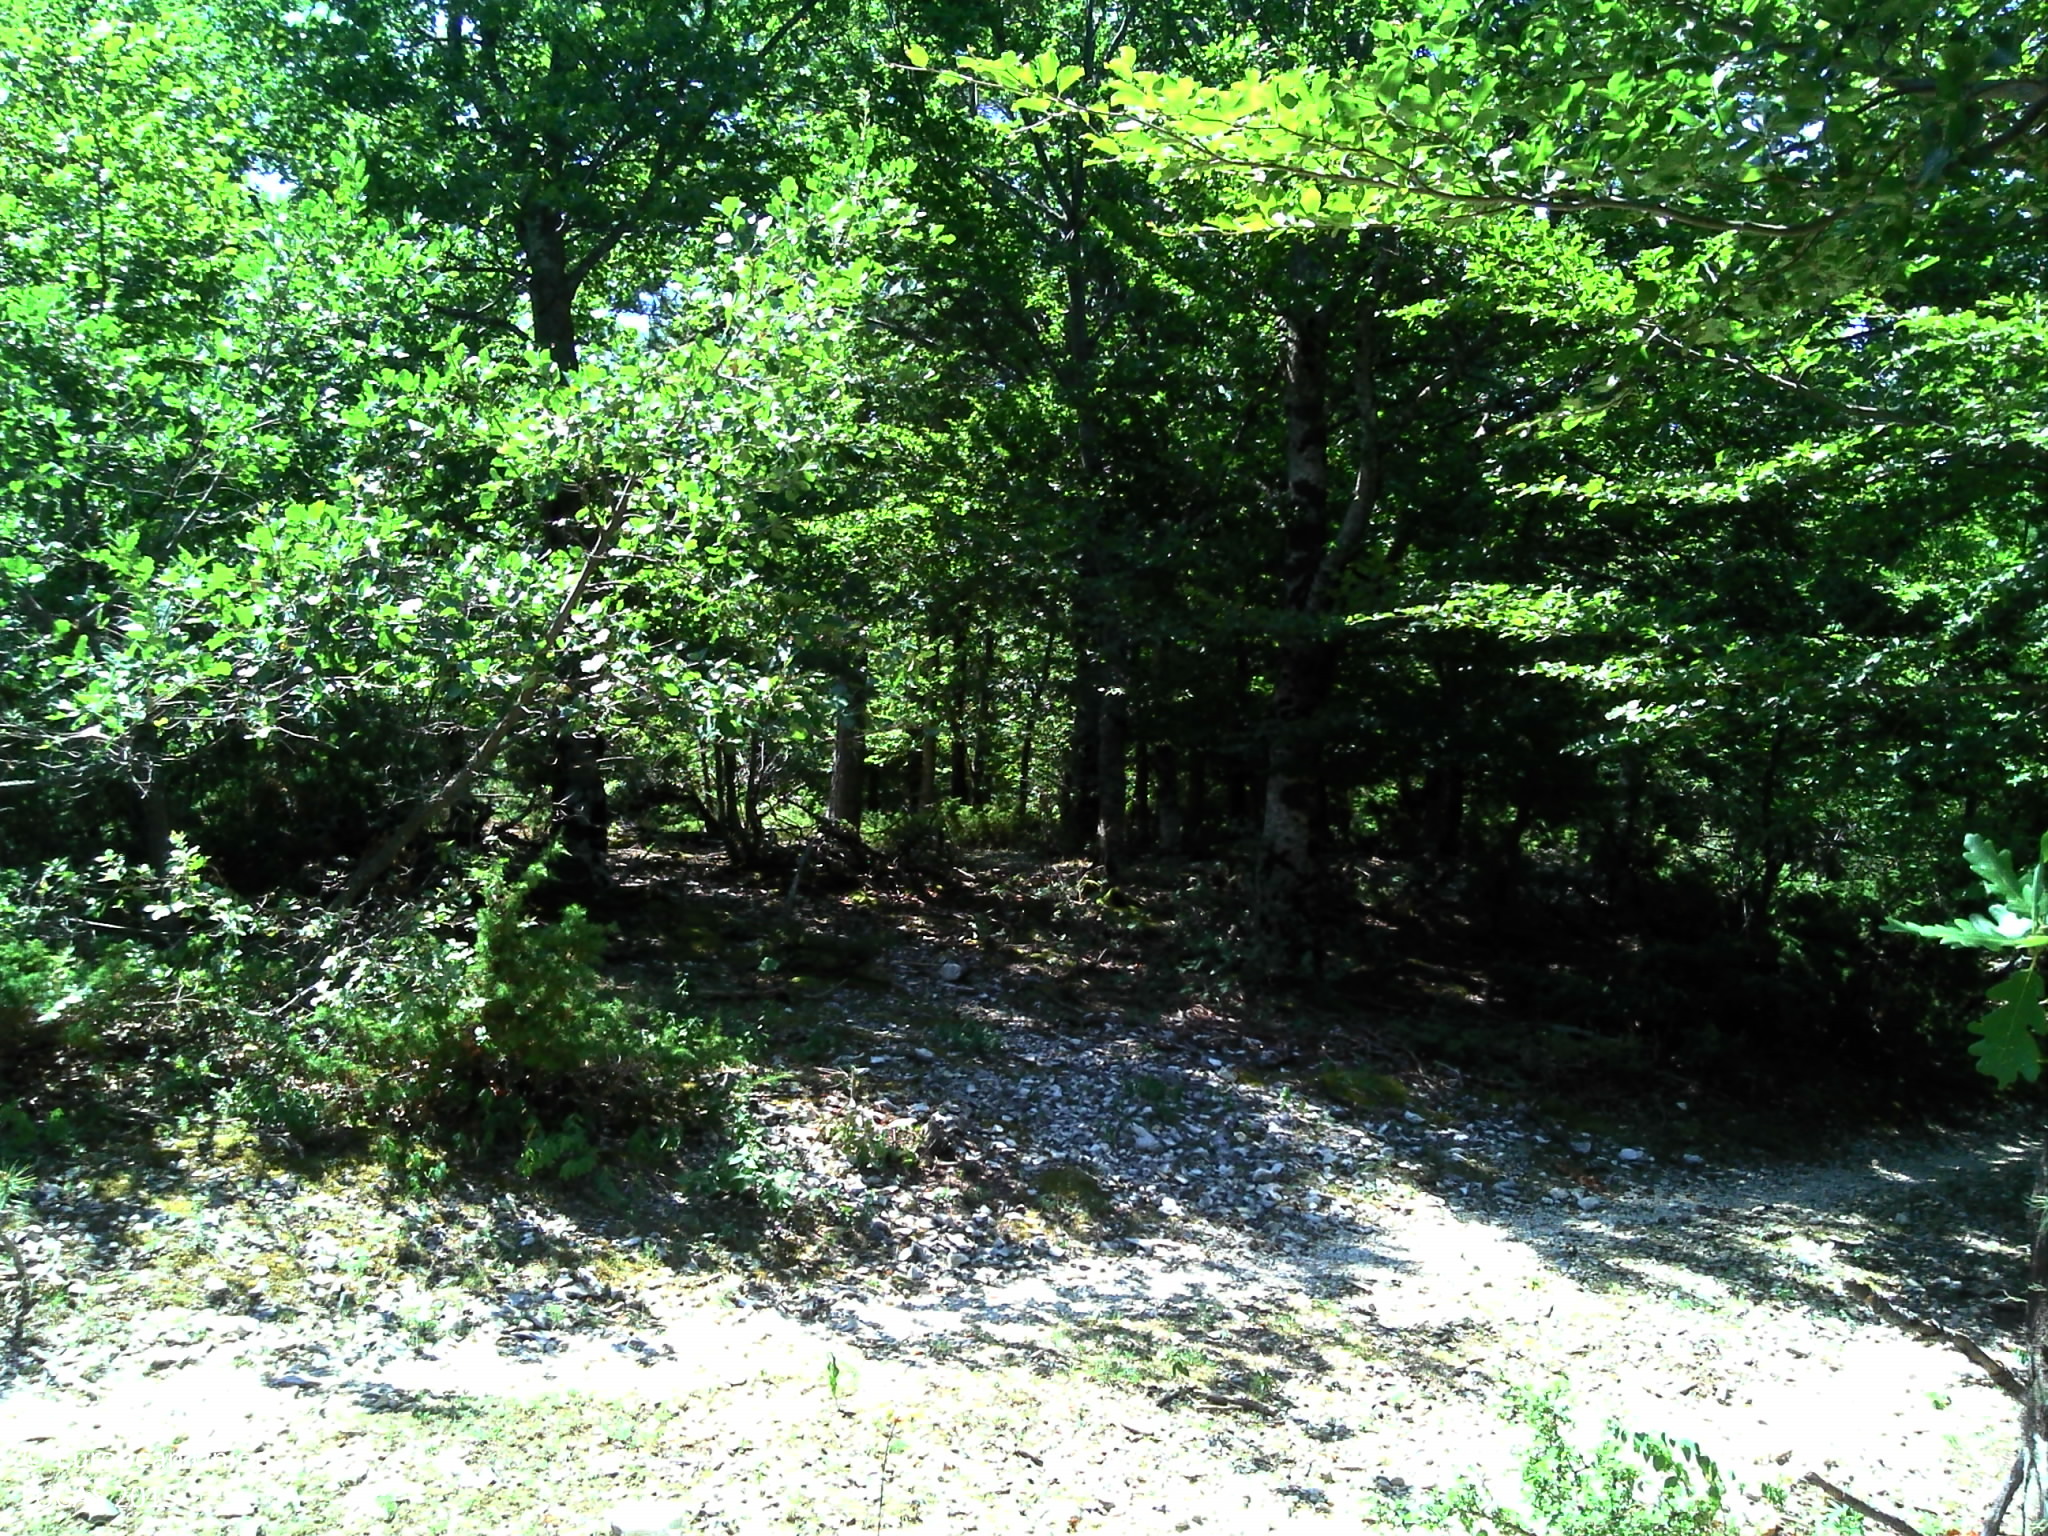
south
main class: Woodland
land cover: Broadleaved woodland
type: broadleaved evergreen forest
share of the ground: > 75 %
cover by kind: broadleaved forest trees 75 %, shrubs 20 %, herbaceous plants 5 %
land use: Semi-natural and natural areas not in use
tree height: > 5 m
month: July
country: FR
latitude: 44.1355
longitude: 5.2957
